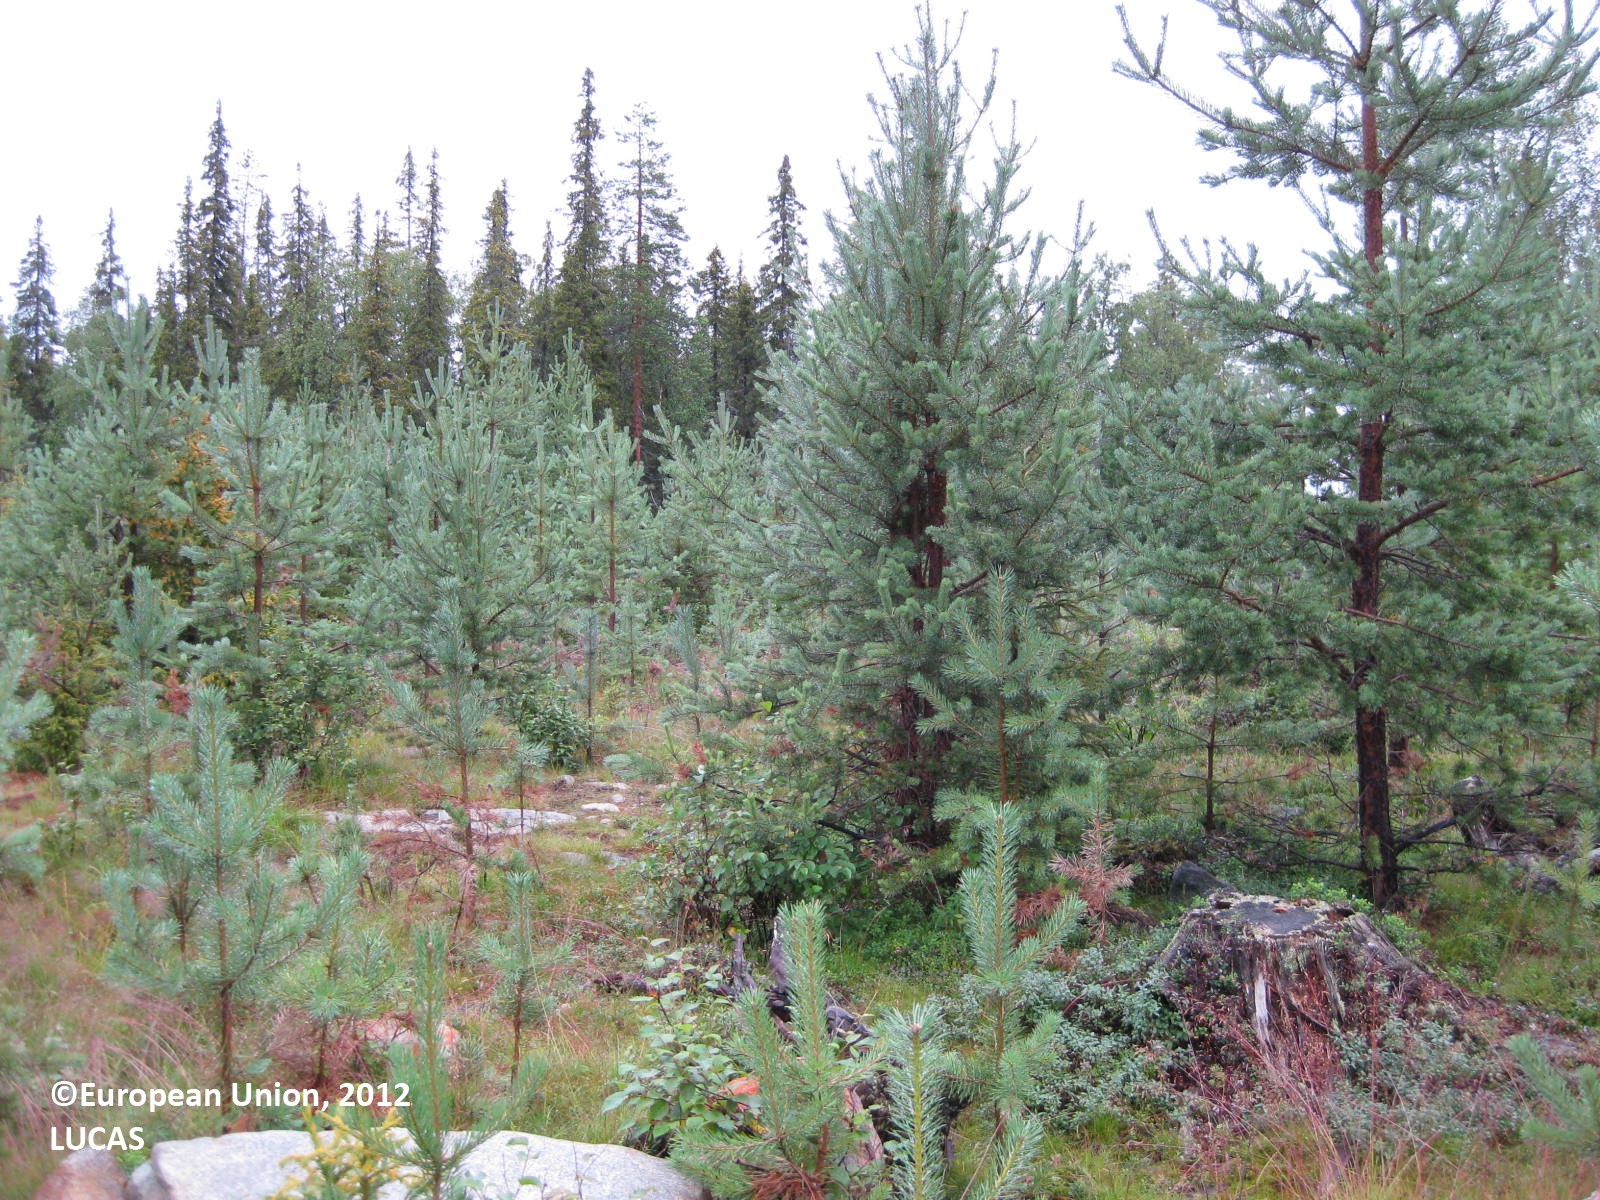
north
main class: Woodland
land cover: Pine dominated coniferous woodland
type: boreal forest
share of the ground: 50 - 75 %
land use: Forestry
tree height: < 5 m
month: August
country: FI
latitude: 65.8325
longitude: 28.2057
